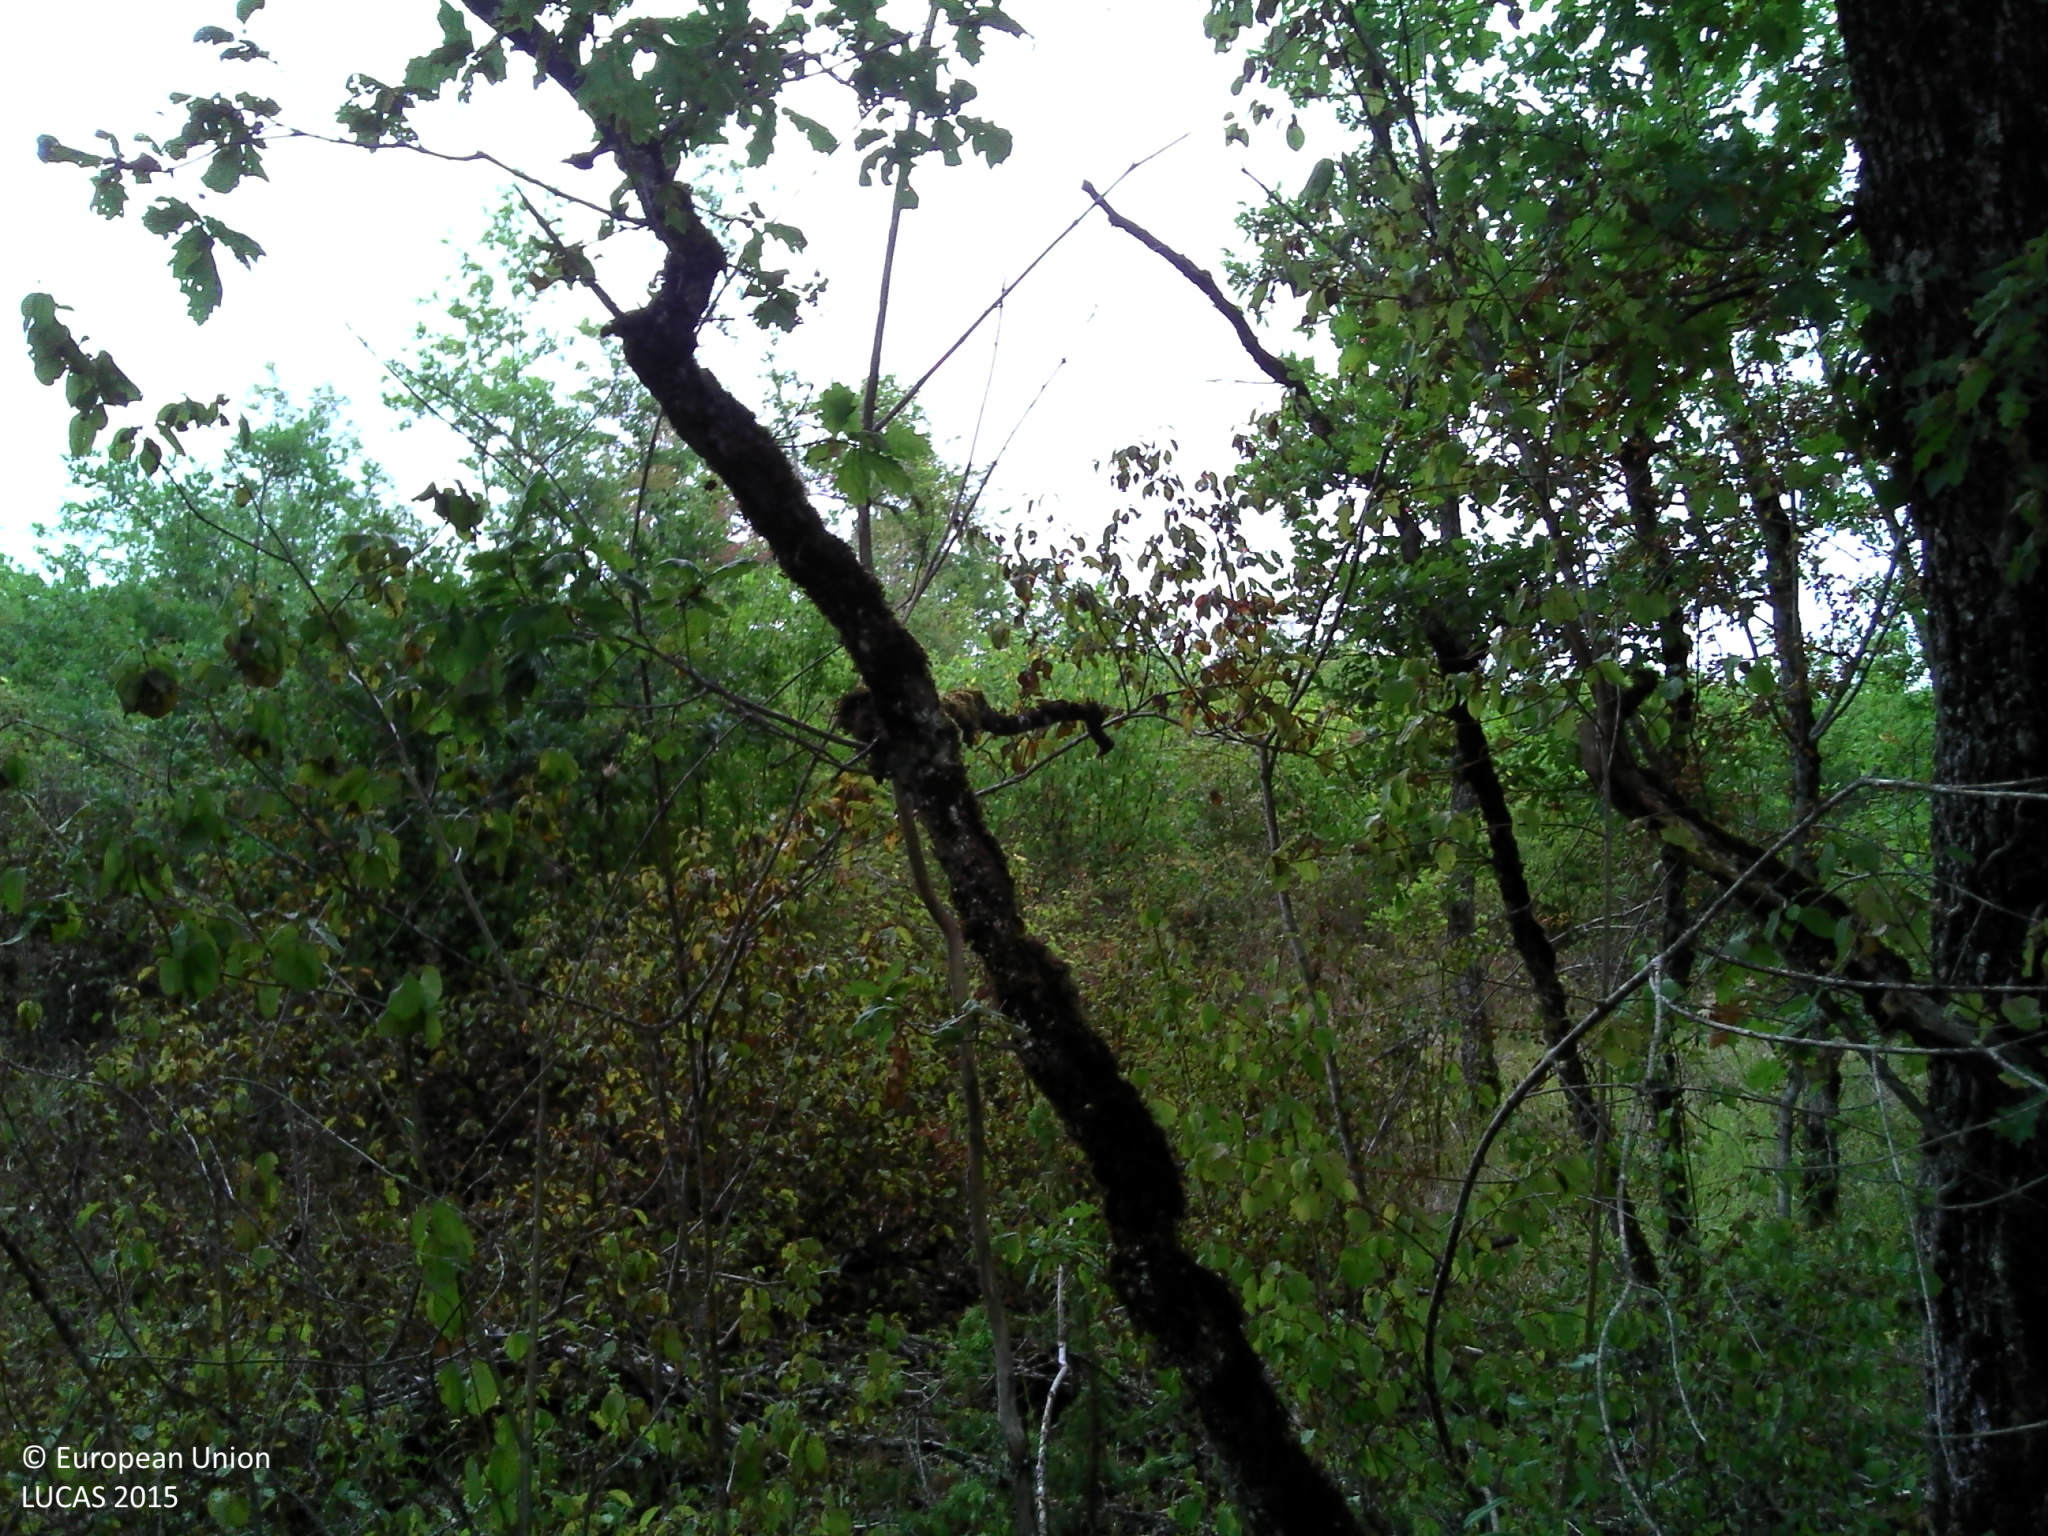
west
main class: Woodland
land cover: Broadleaved woodland
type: acidophilous oak and oak-birch forest
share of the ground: > 75 %
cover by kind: broadleaved forest trees 65 %, herbaceous plants 25 %, coniferous forest trees 5 %, shrubs 5 %
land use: Forestry
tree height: > 5 m
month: July
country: FR
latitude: 45.0106
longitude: 1.4309
